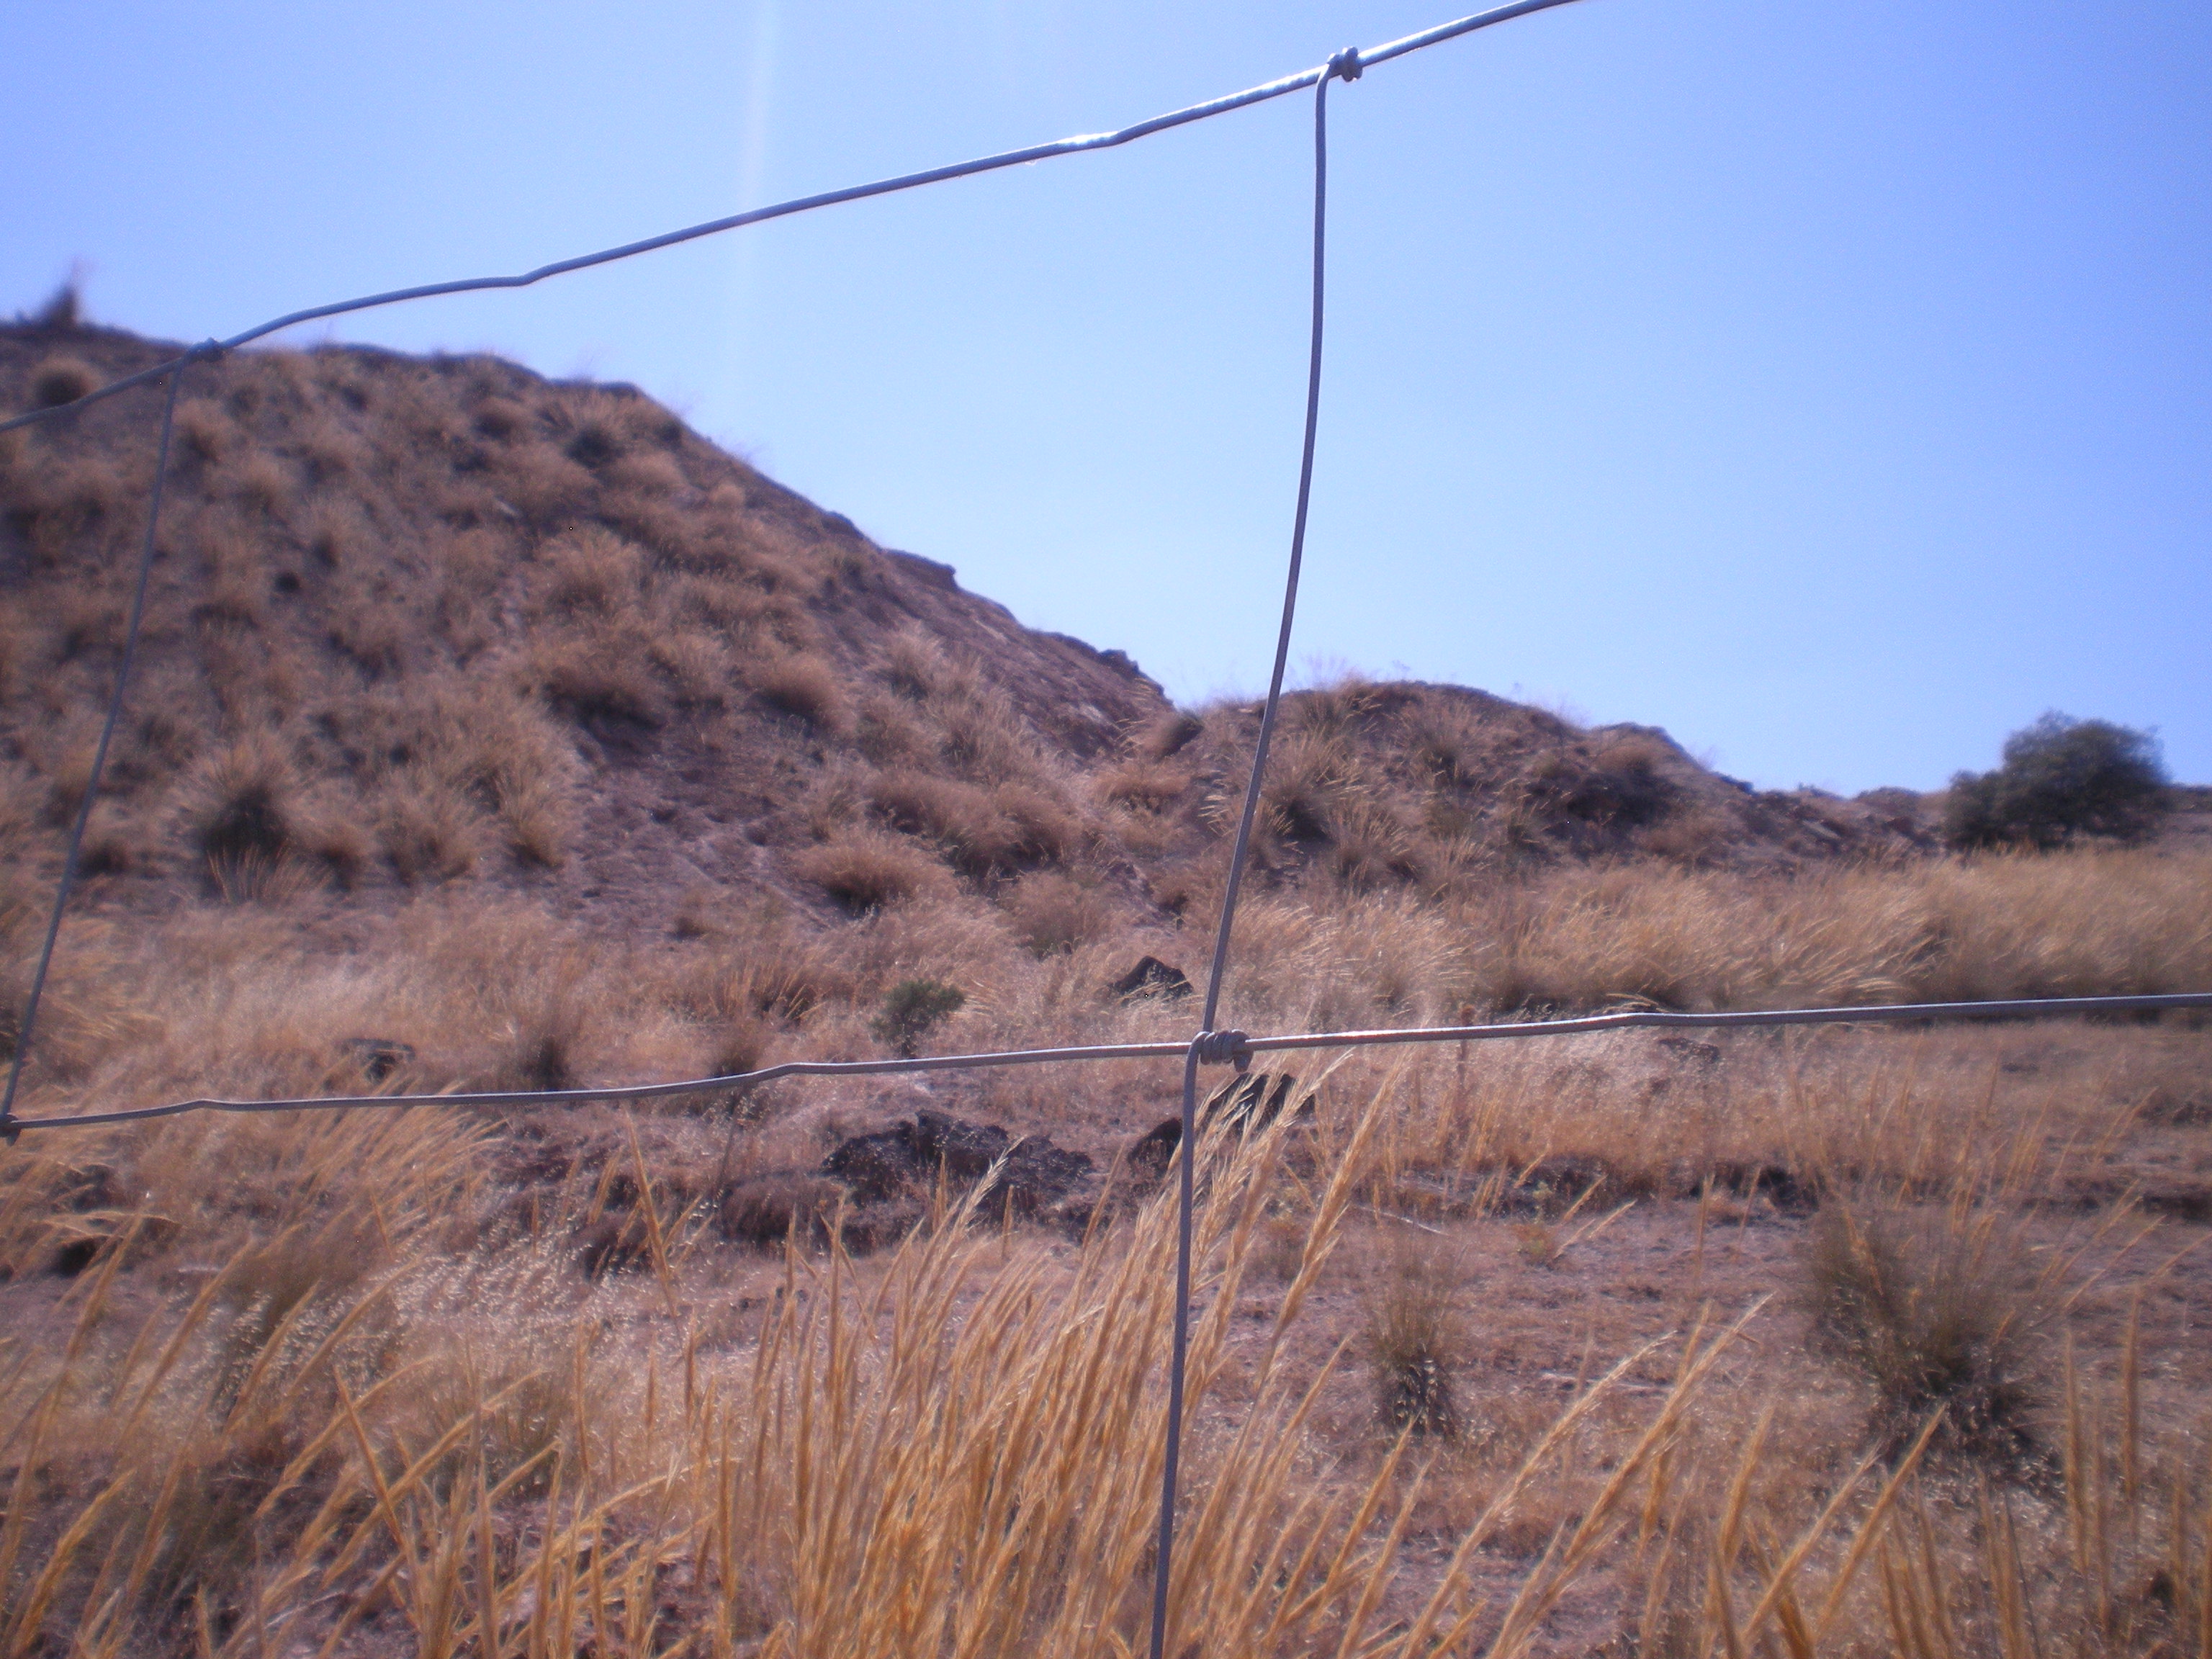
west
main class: Grassland
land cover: Grassland without tree/shrub cover
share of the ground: 25 - 50 %
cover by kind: unconsolidated bare surface 70 %, herbaceous plants 30 %
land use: Semi-natural and natural areas not in use
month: July
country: ES
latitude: 39.3667
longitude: -3.4963
